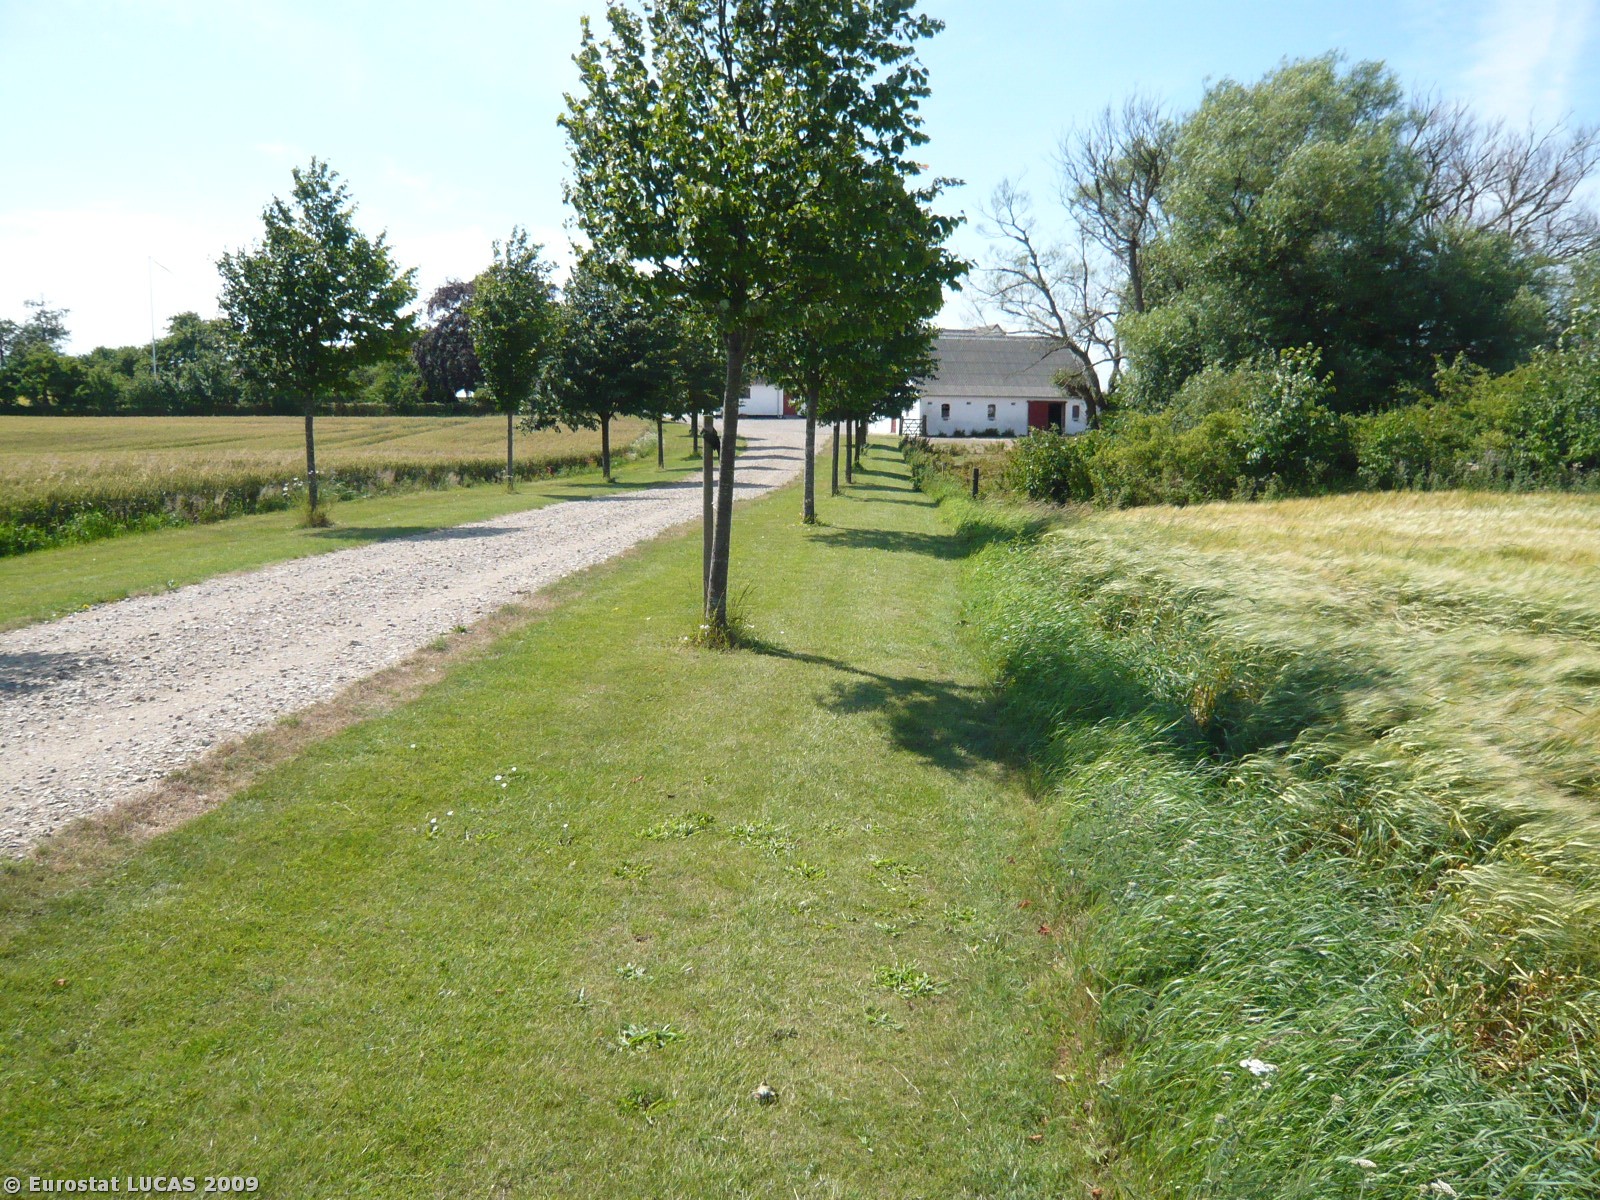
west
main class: Cropland
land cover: Barley
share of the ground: > 75 %
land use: Agriculture (excluding fallow land and kitchen gardens)
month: July
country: DK
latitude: 55.6974
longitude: 11.1285
